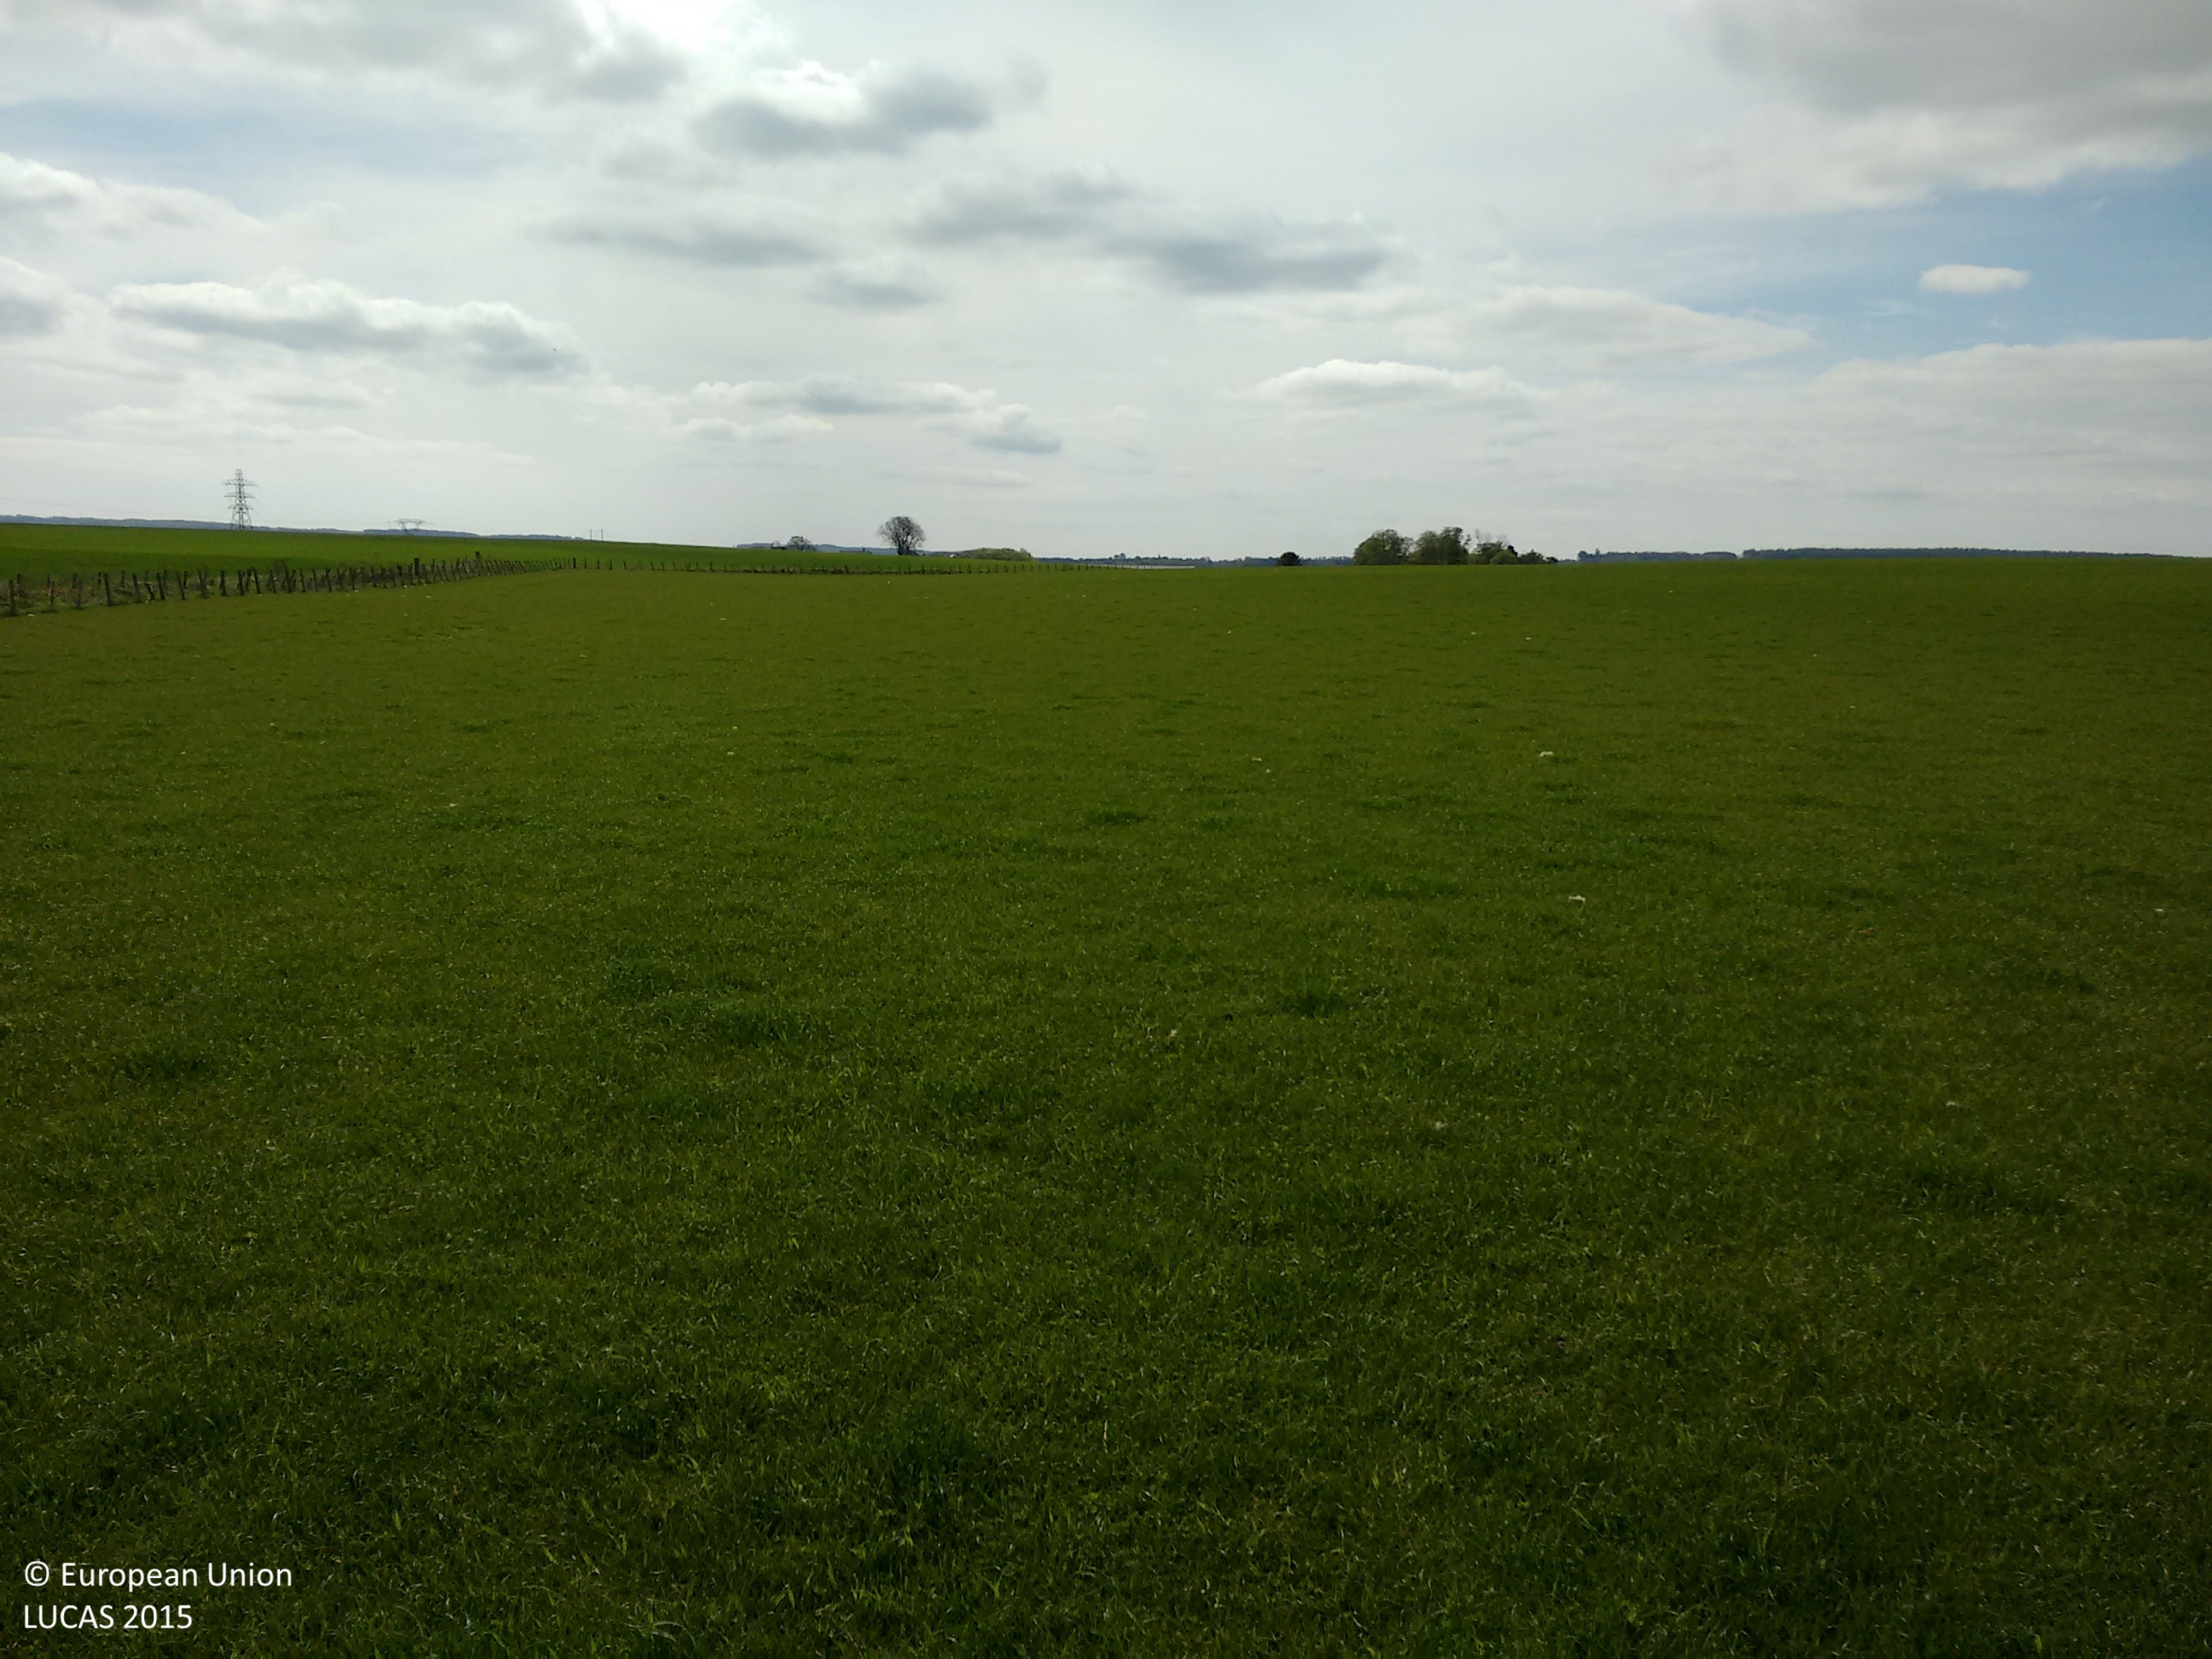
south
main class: Grassland
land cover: Grassland without tree/shrub cover
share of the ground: > 75 %
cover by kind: herbaceous plants 100 %
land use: Agriculture (excluding fallow land and kitchen gardens)
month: May
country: GB
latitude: 56.7451
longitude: -2.6323
